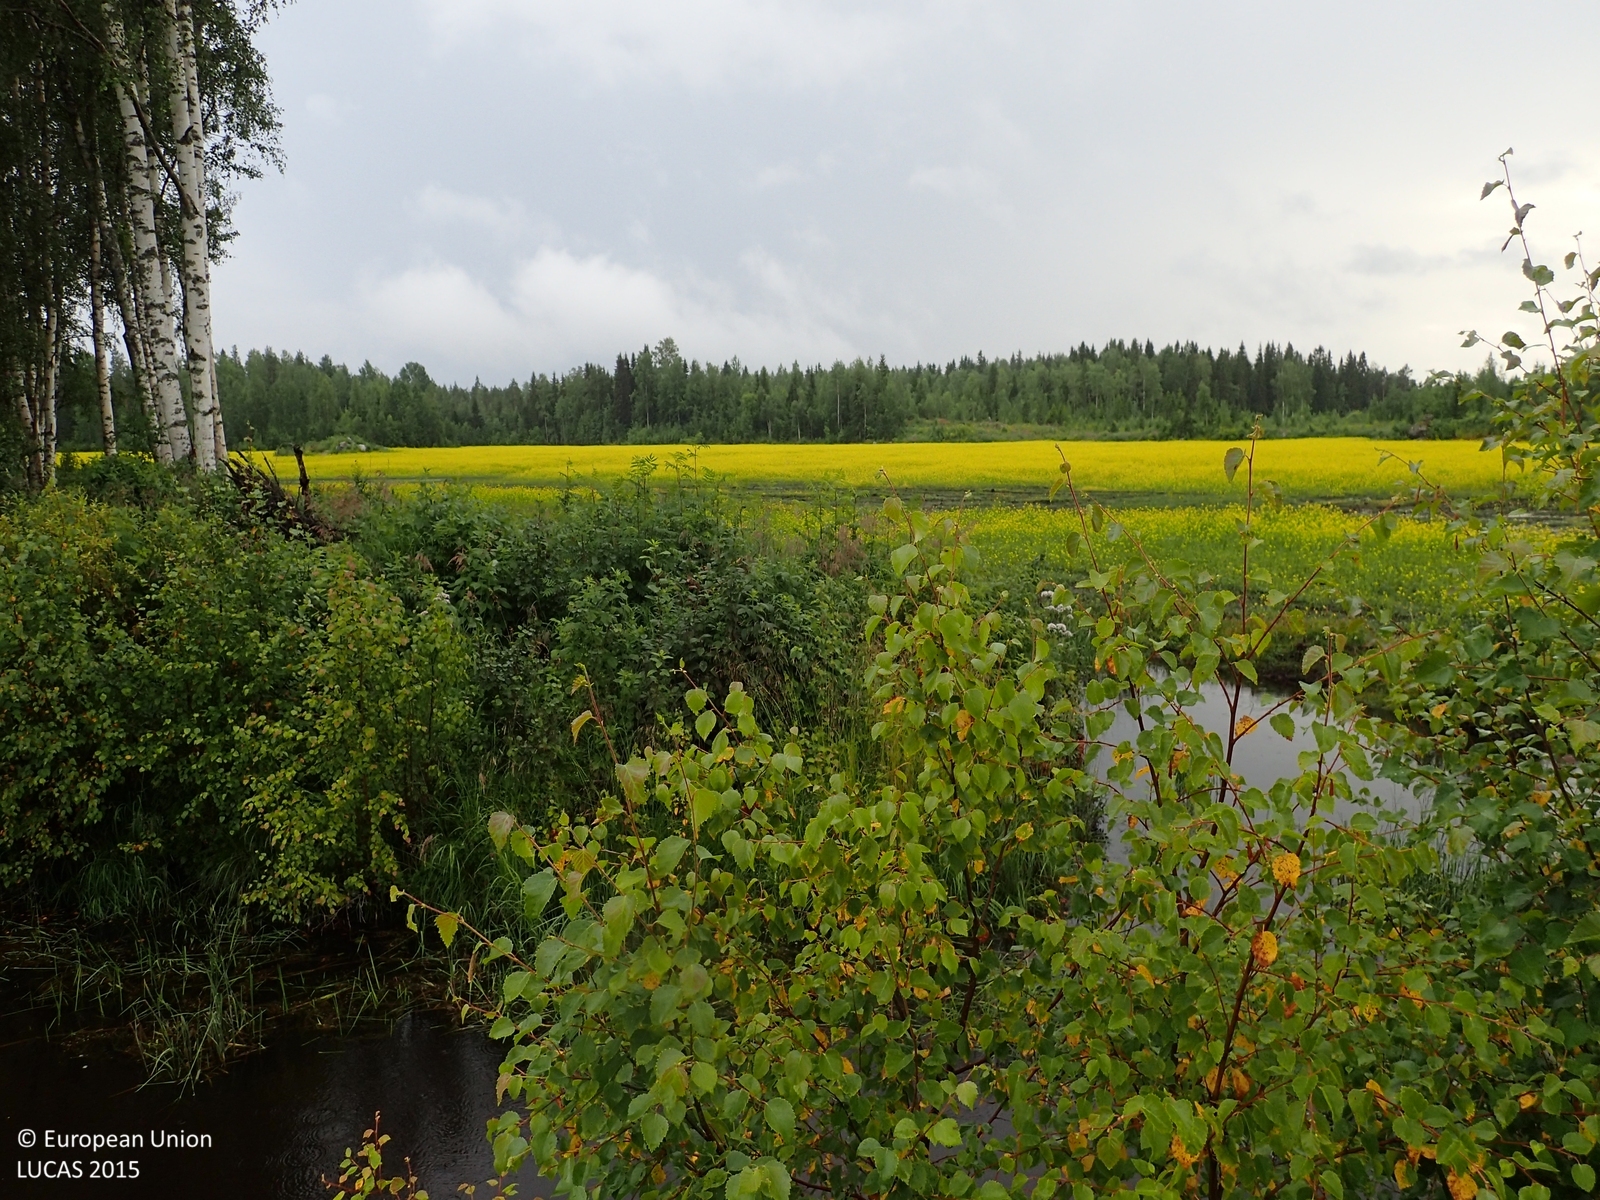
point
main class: Cropland
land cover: Rape and turnip rape
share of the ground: > 75 %
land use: Agriculture (excluding fallow land and kitchen gardens)
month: July
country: FI
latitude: 63.0145
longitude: 22.5962
